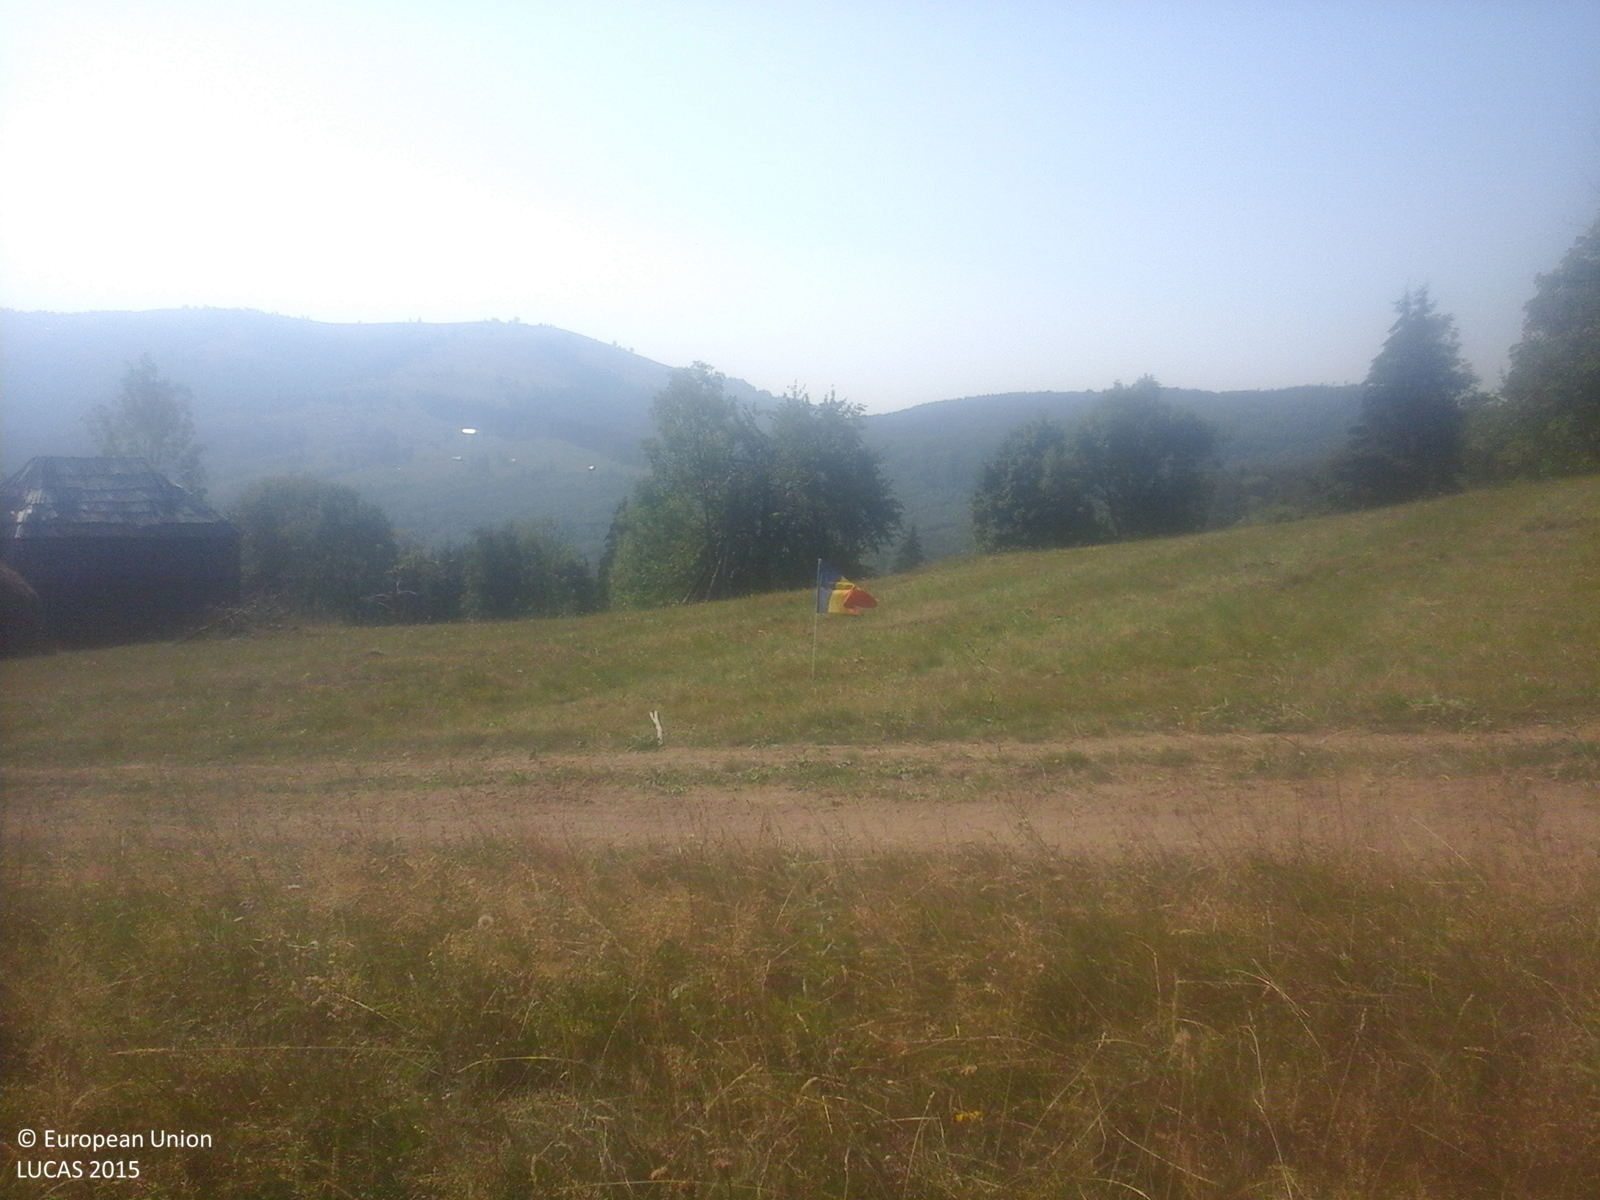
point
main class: Grassland
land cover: Grassland without tree/shrub cover
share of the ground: > 75 %
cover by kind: herbaceous plants 100 %
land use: Agriculture (excluding fallow land and kitchen gardens)
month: September
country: RO
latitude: 47.5845
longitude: 24.3853
